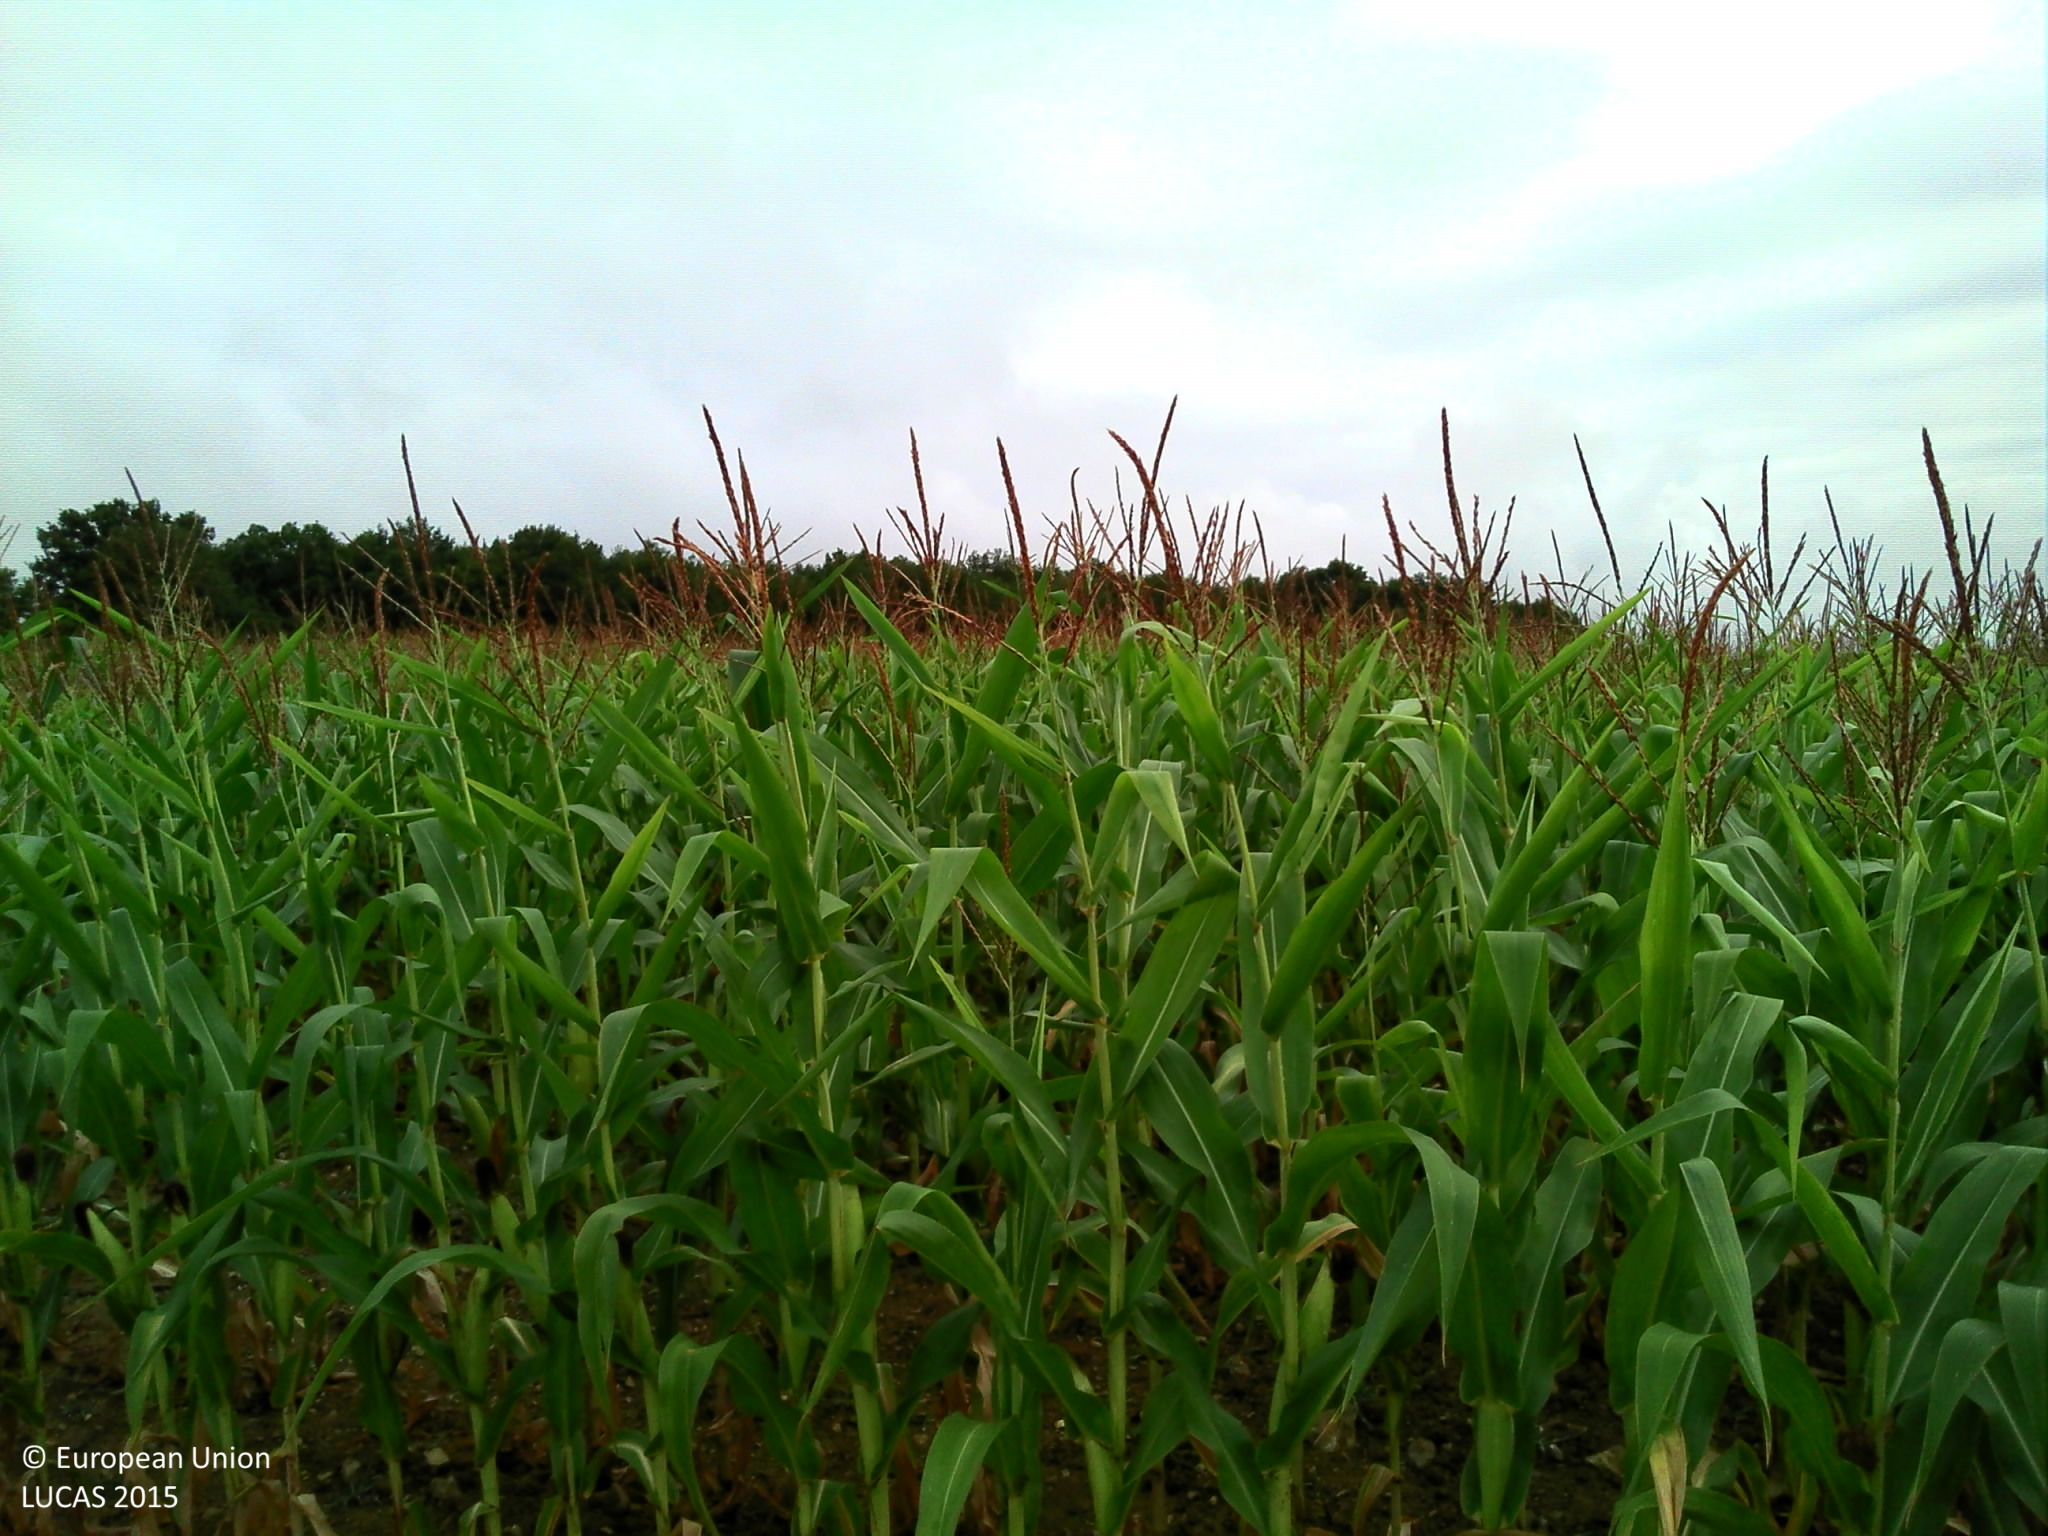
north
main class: Cropland
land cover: Maize
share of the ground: > 75 %
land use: Agriculture (excluding fallow land and kitchen gardens)
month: July
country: FR
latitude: 46.4625
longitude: 0.2012
